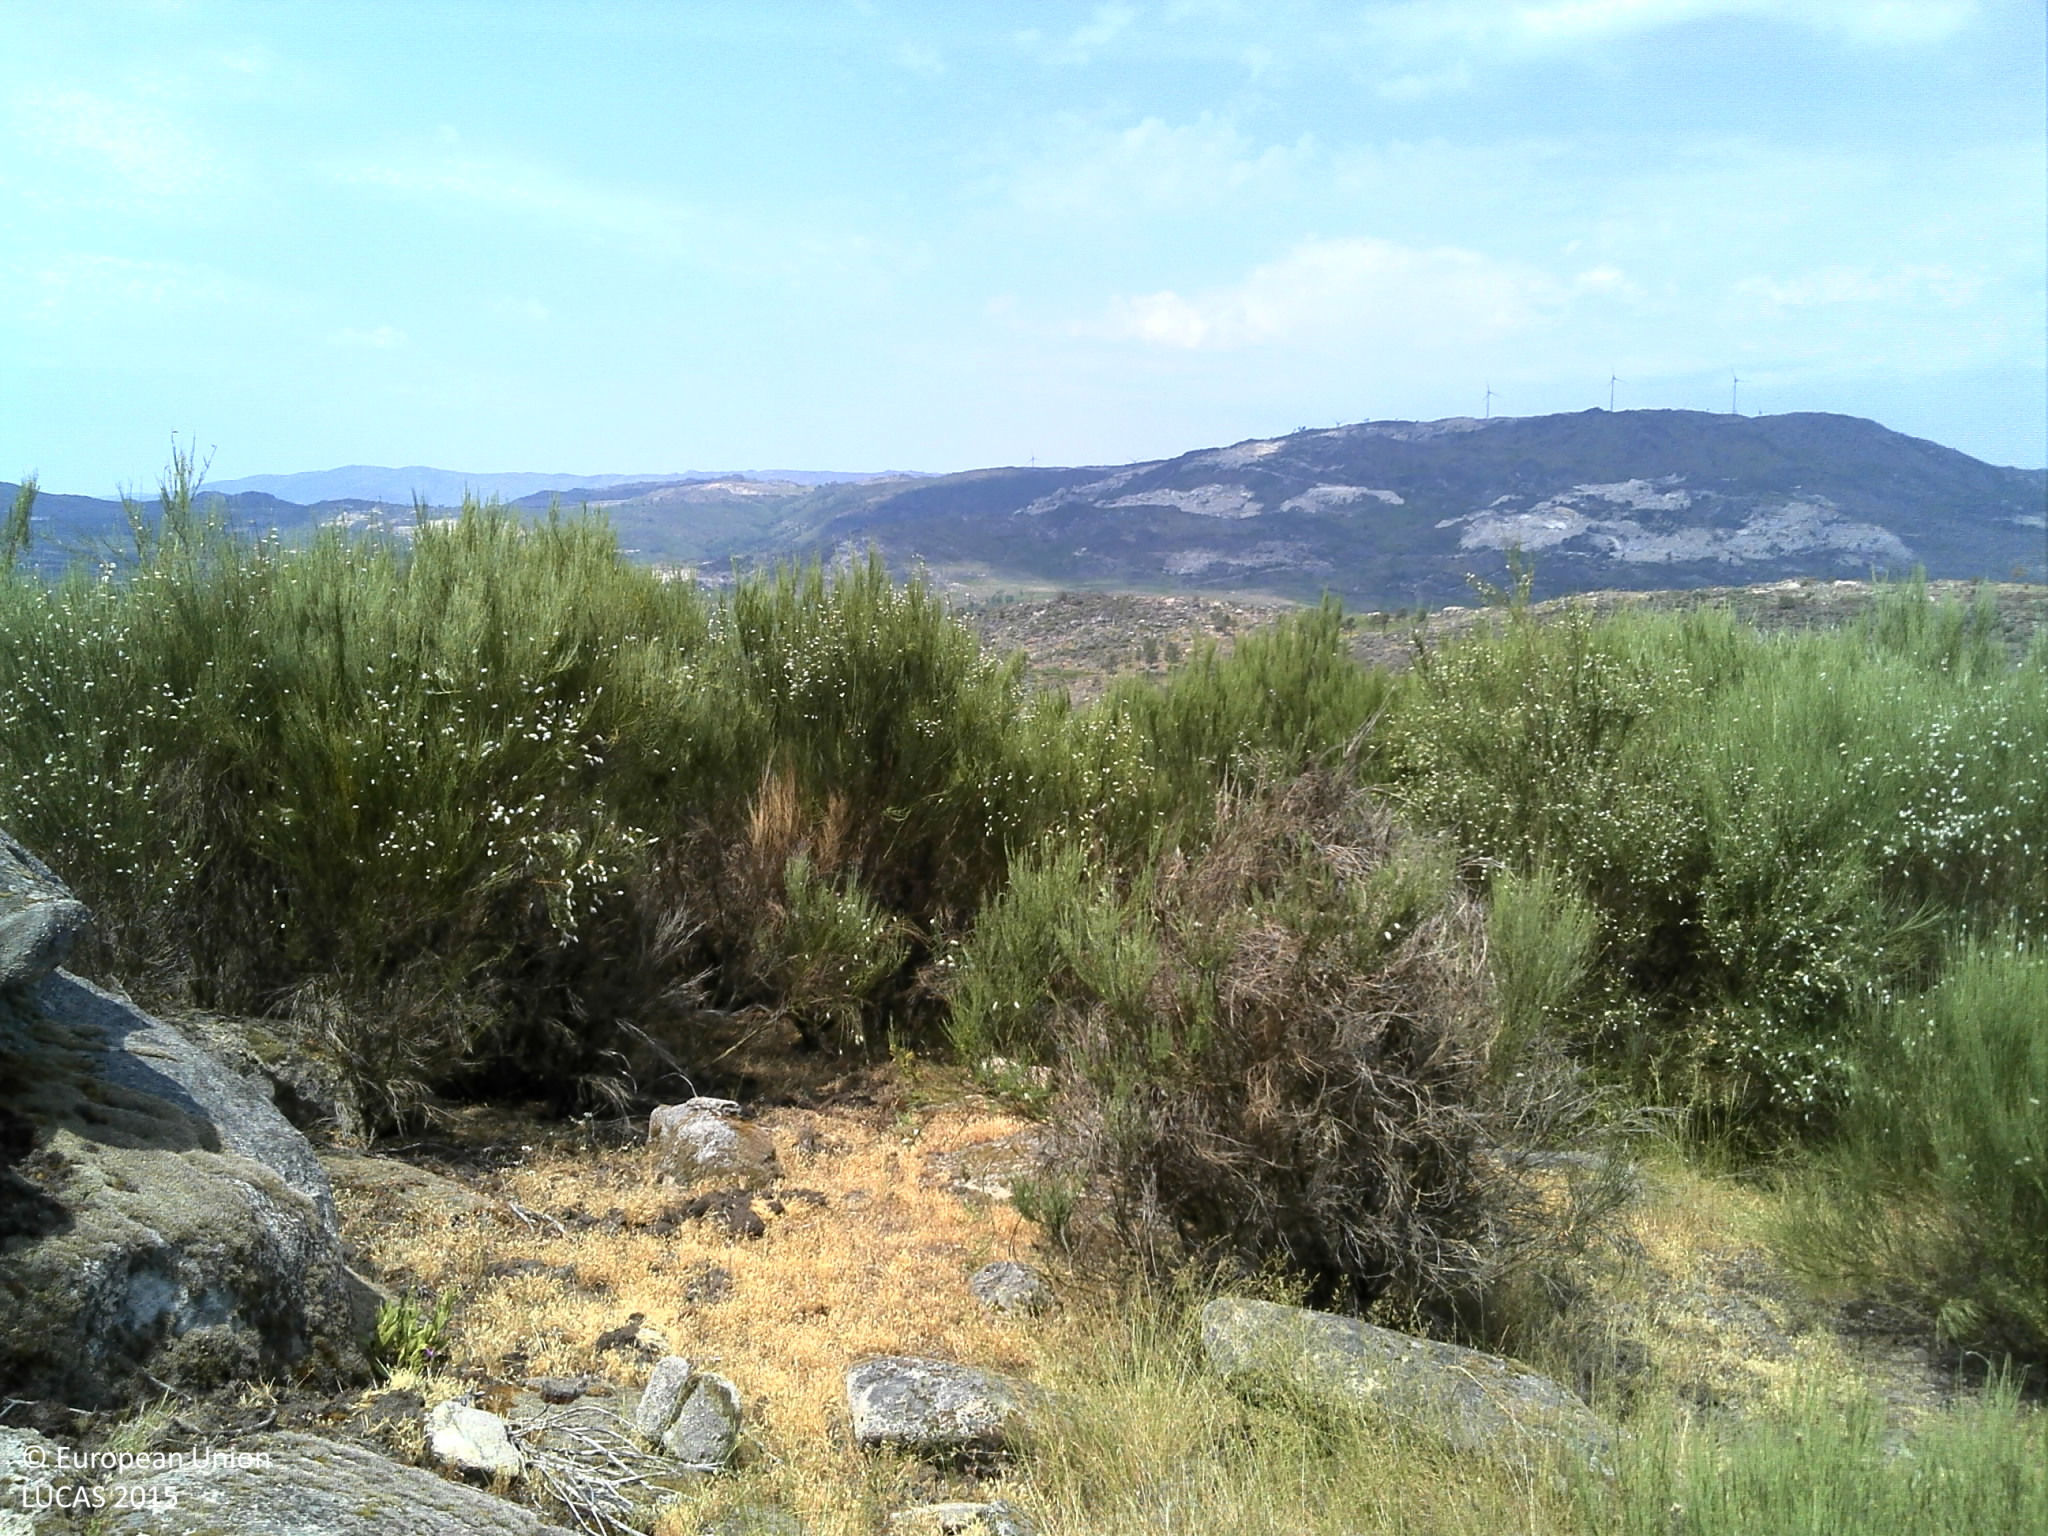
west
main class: Shrubland
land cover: Shrubland without tree cover
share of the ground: > 75 %
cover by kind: shrubs 50 %, consolidated bare surface 45 %, herbaceous plants 5 %
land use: Semi-natural and natural areas not in use
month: June
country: PT
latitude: 41.3975
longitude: -7.5782
